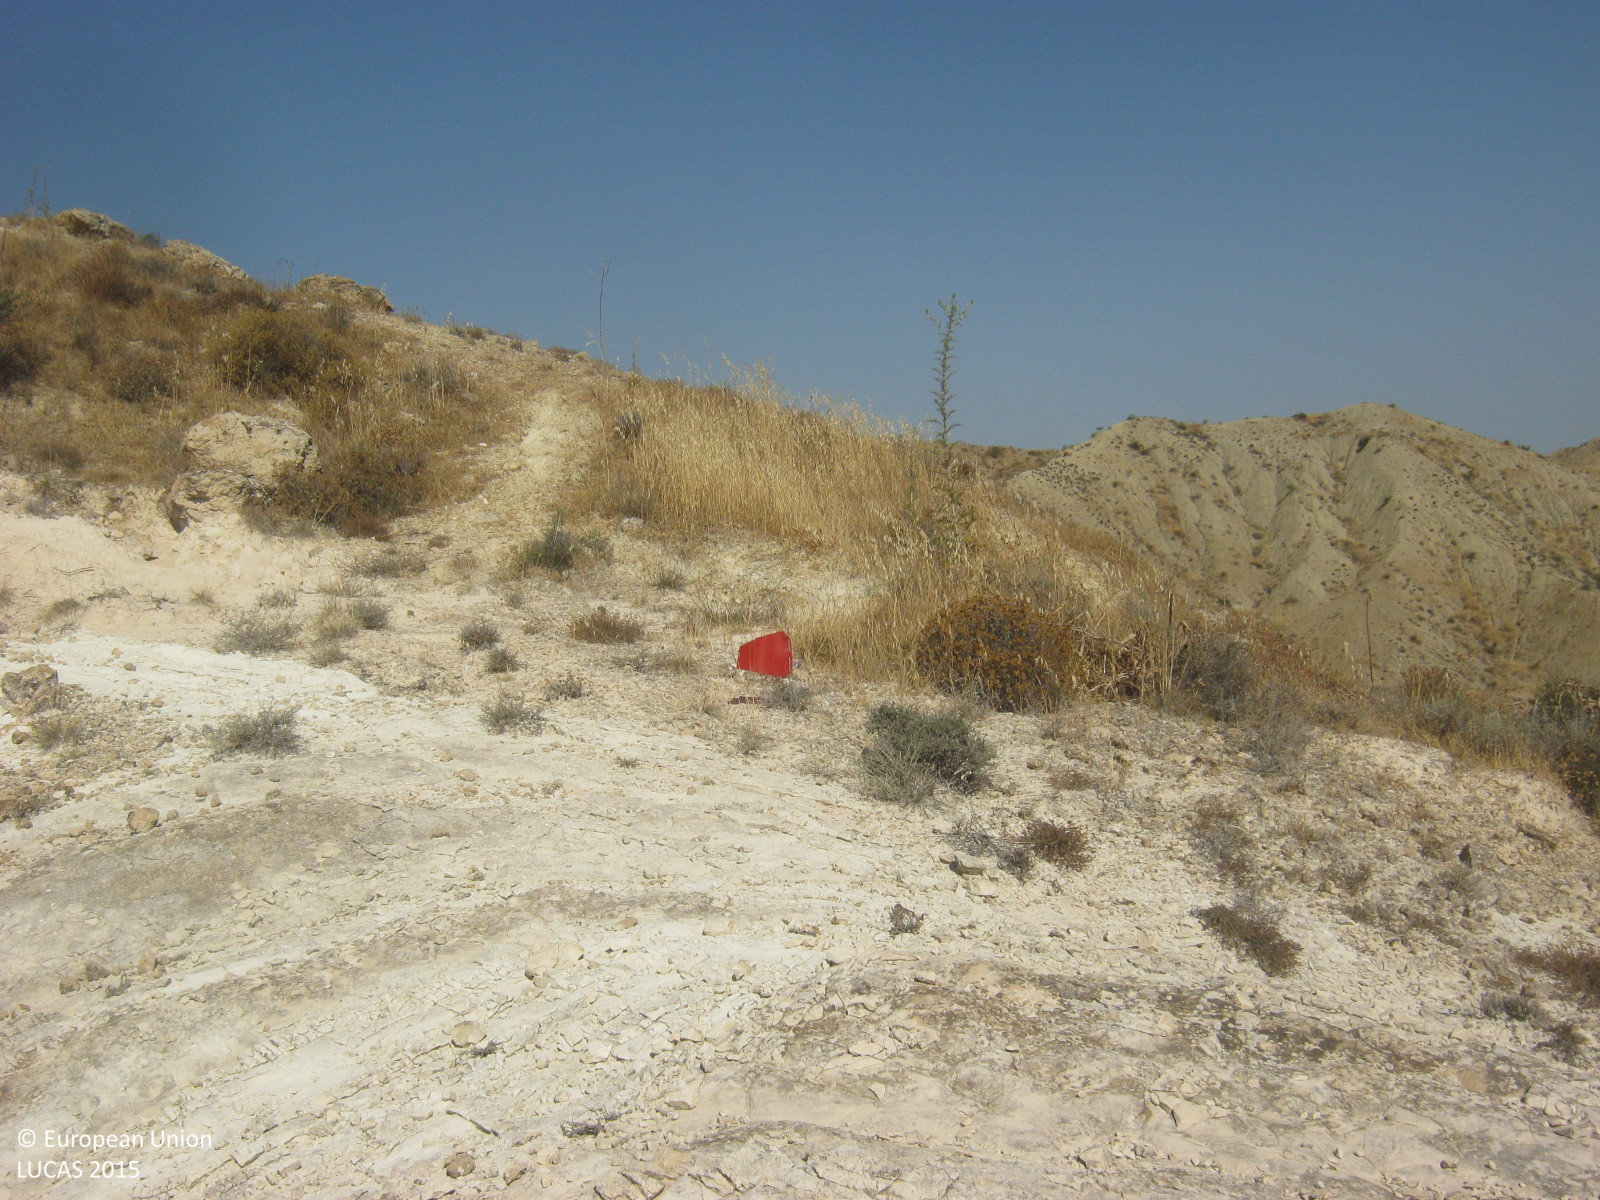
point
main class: Shrubland
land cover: Shrubland without tree cover
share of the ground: 10 - 25 %
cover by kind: unconsolidated bare surface 60 %, shrubs 20 %, herbaceous plants 20 %
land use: Semi-natural and natural areas not in use
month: June
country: CY
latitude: 35.0390
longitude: 33.2147
